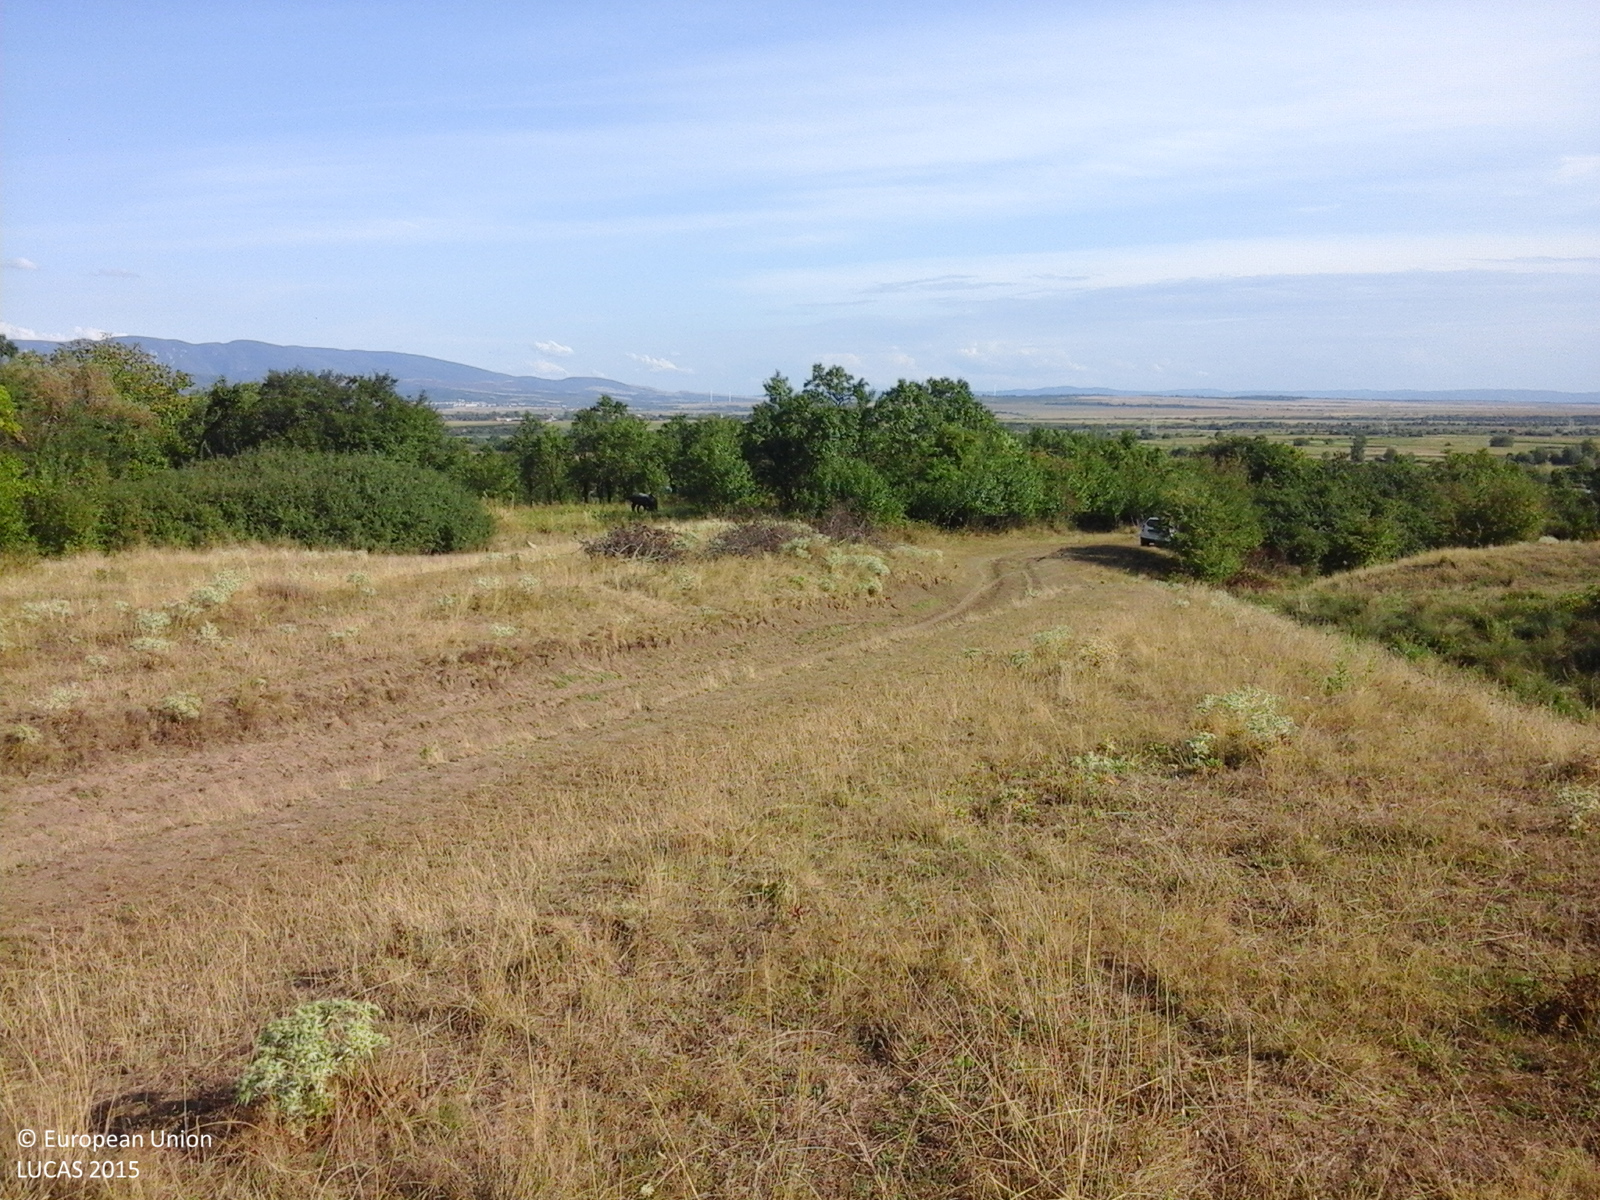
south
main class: Grassland
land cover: Spontaneously vegetated surfaces
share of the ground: > 75 %
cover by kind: herbaceous plants 100 %
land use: Semi-natural and natural areas not in use
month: August
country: RO
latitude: 45.1189
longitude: 21.5863
